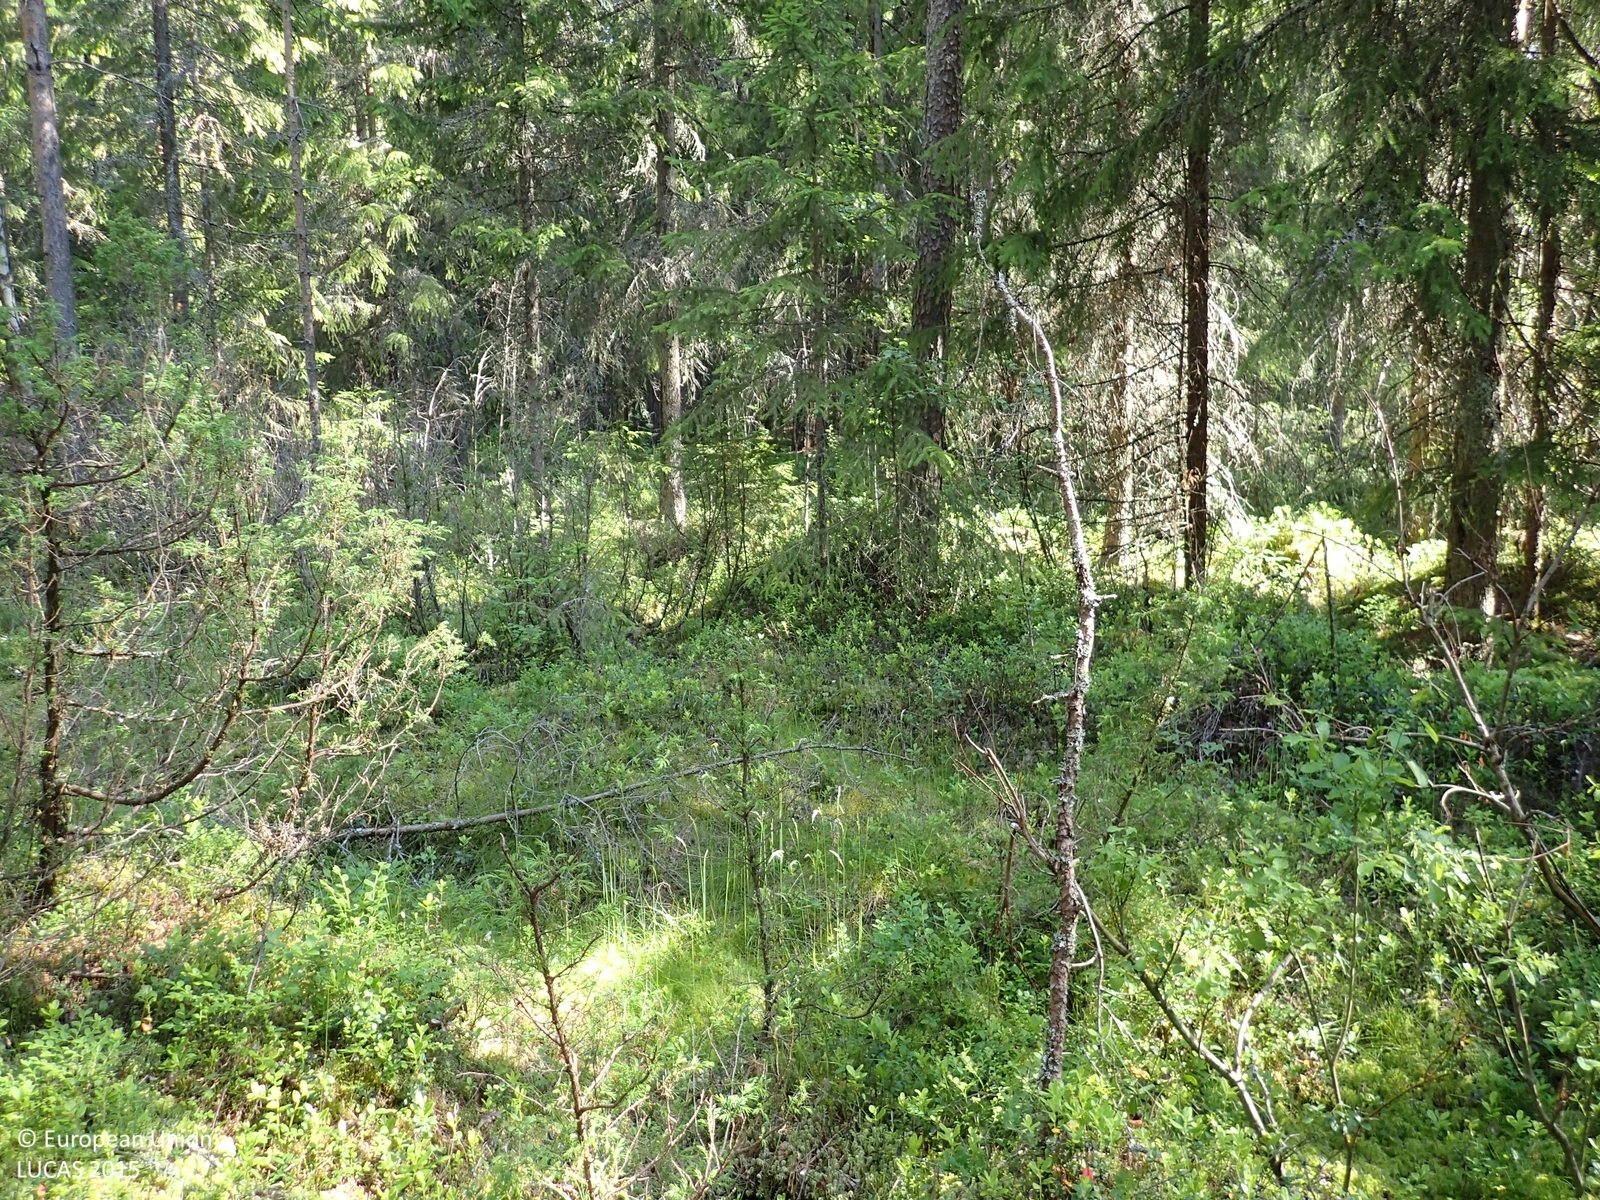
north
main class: Woodland
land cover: Other coniferous woodland
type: boreal forest
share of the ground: 50 - 75 %
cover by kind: coniferous forest trees 60 %, shrubs 35 %, lichens and mosses 5 %
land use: Forestry
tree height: > 5 m
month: July
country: FI
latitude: 62.7106
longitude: 21.5971
